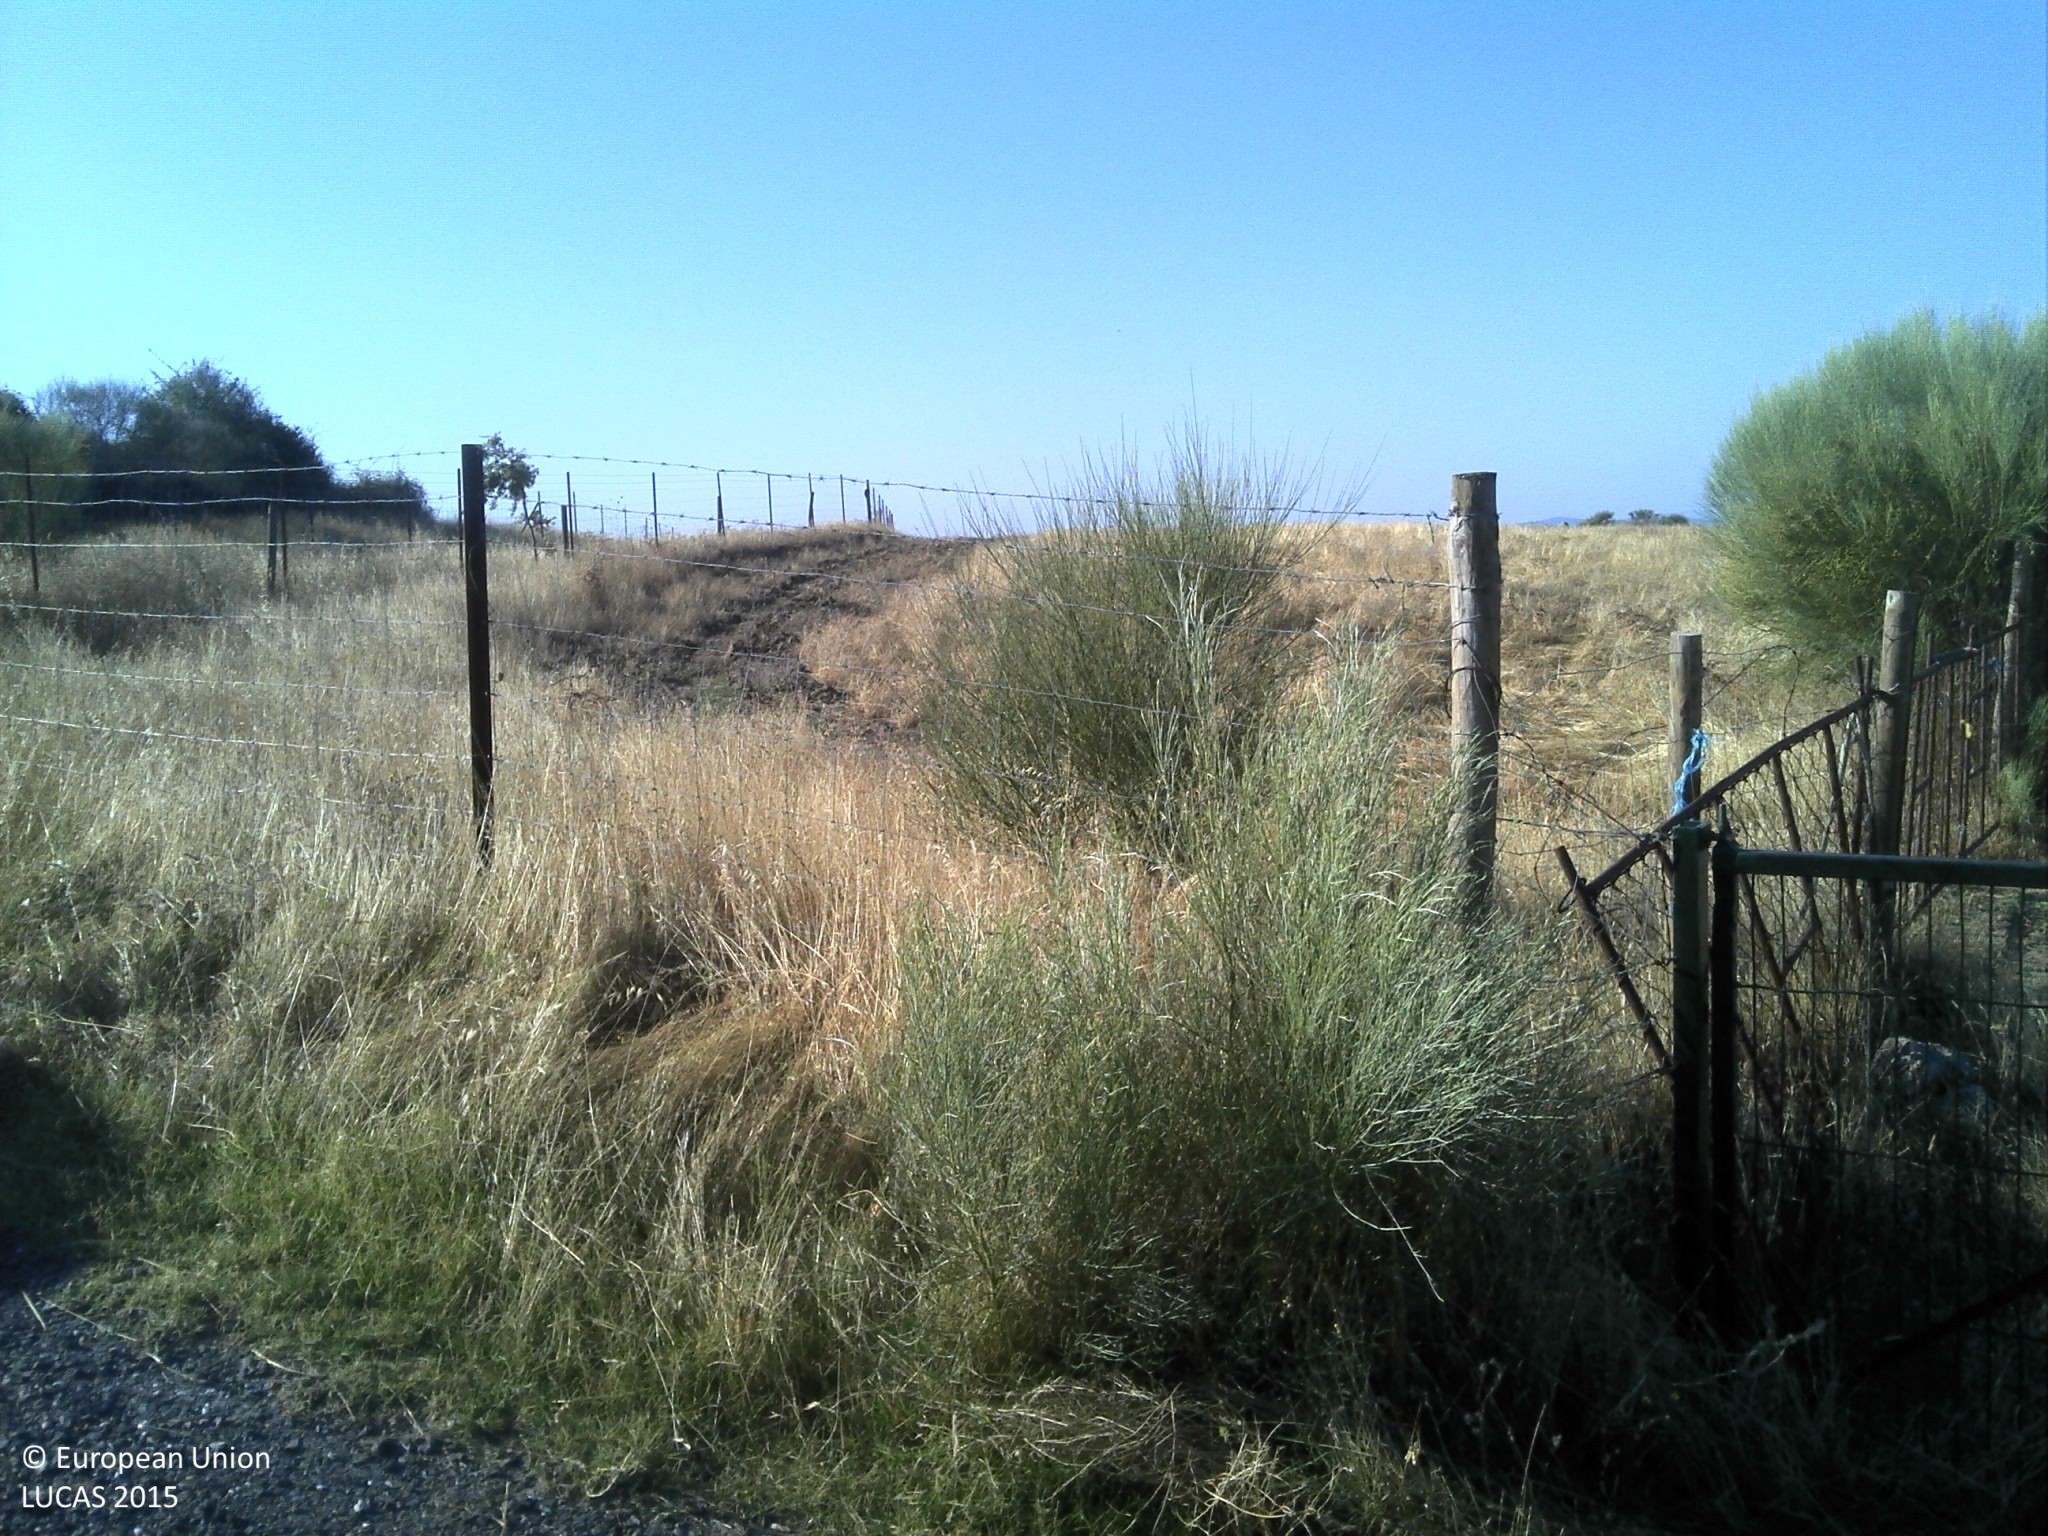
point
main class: Cropland
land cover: Arable land (only in case pi)
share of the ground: 50 - 75 %
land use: Agriculture (excluding fallow land and kitchen gardens)
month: June
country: PT
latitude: 39.9157
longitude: -7.3052
